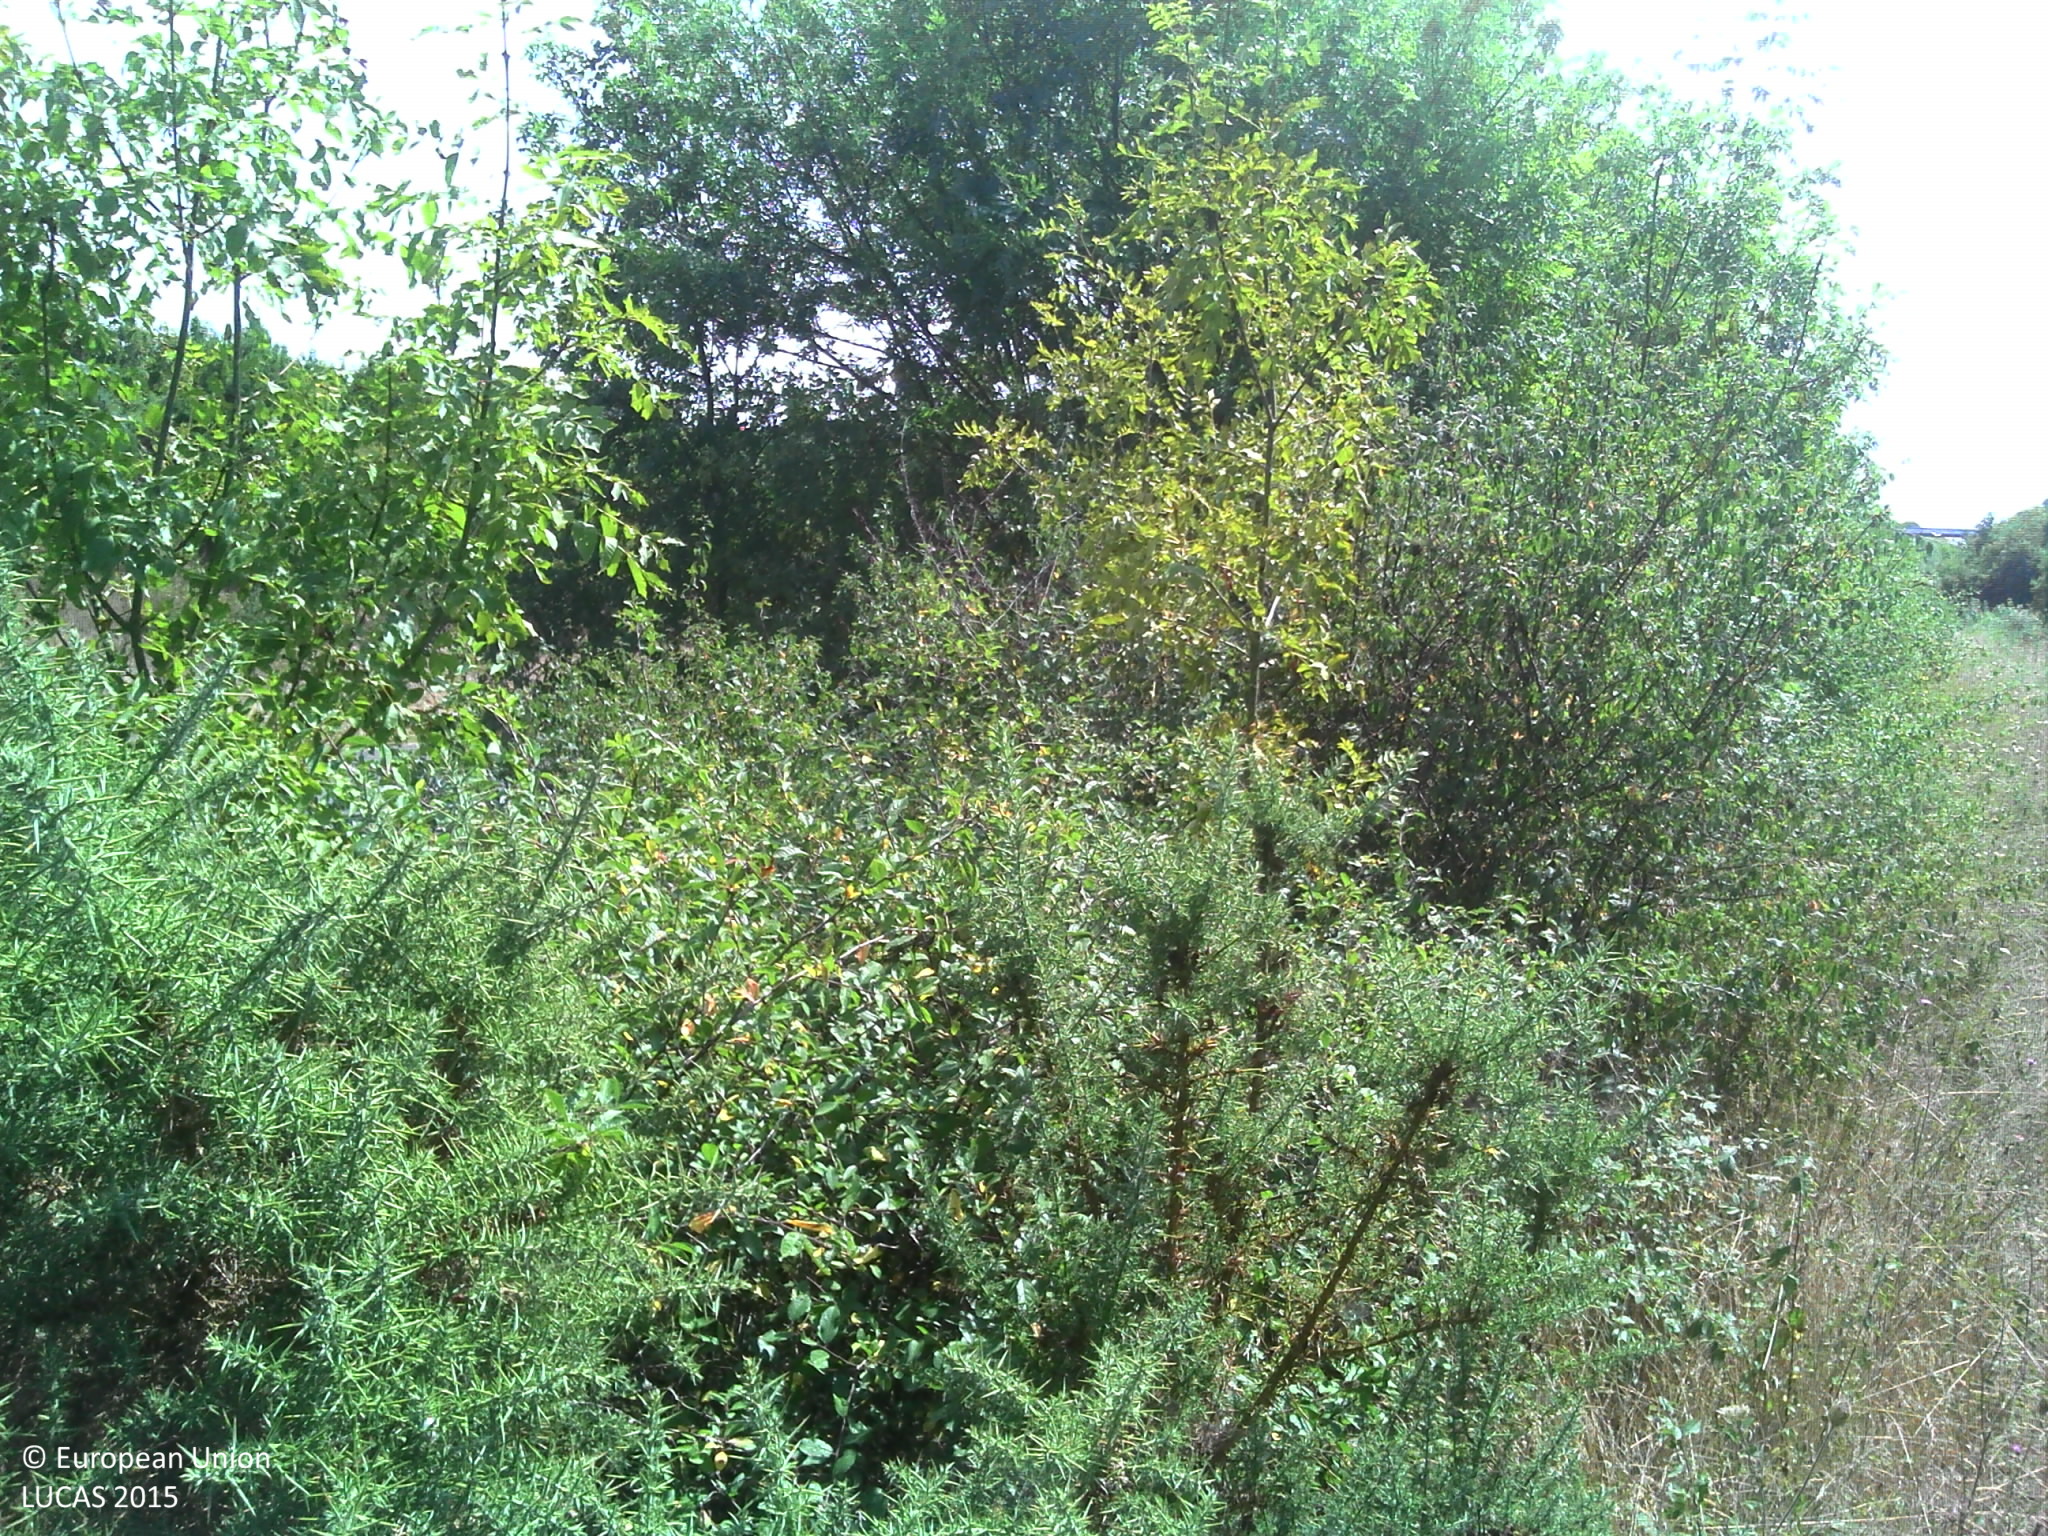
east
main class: Woodland
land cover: Broadleaved woodland
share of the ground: > 75 %
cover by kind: broadleaved forest trees 90 %, shrubs 10 %
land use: Road transport
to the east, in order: Broadleaved woodland; Grassland without tree/shrub cover; Ditches and canals; Fences; Paved roads, cycling and walking lanes; Ditches and canals; Grassland without tree/shrub cover; Shrubland without tree cover; Shrubland with sparse tree cover; Grassland without tree/shrub cover; Abandoned hedges; Fences; Ditches and canals; Grass margins; Tracks; Grass margins; Ditches and canals; Fences; Common wheat; Fences; Grassland without tree/shrub cover; Pine dominated coniferous woodland; Fences; Ditches and canals; Broadleaved woodland; Lines of trees; Tracks; Fences; Grass margins; Tracks; Abandoned hedges; Paved roads, cycling and walking lanes
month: August
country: FR
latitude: 46.6563
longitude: -1.1551
